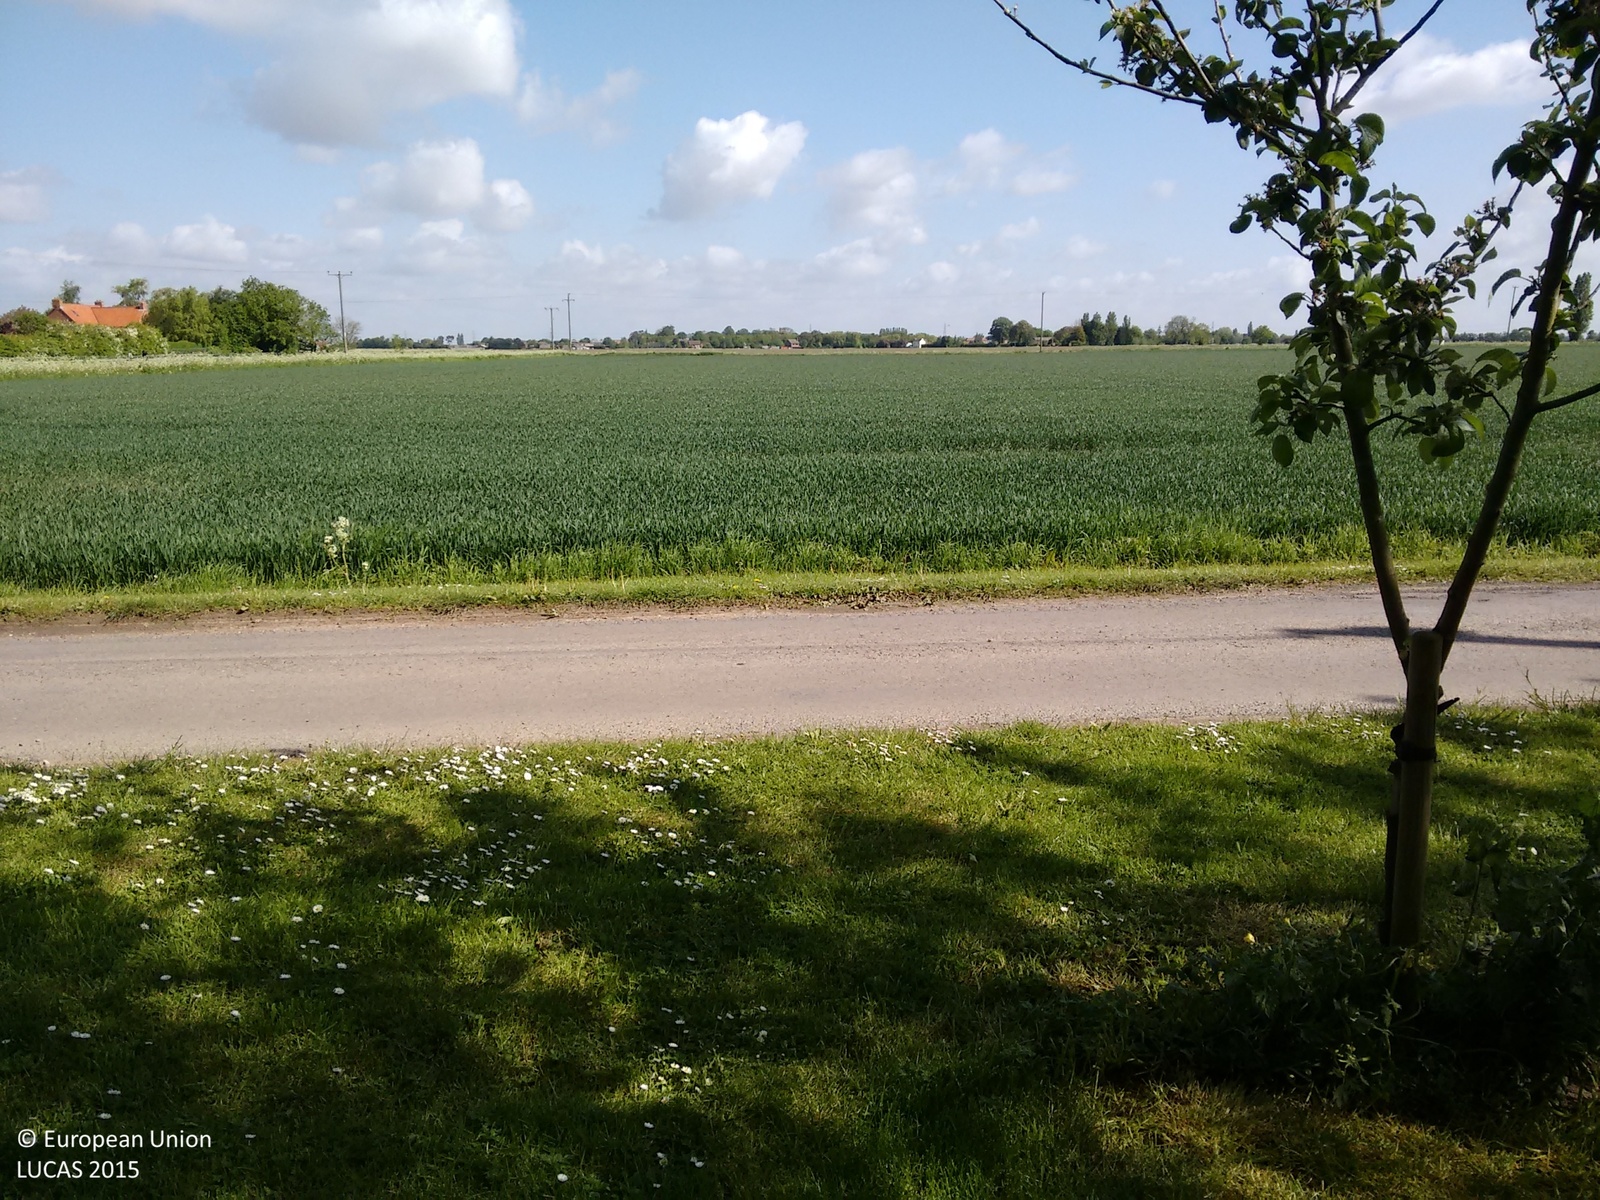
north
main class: Grassland
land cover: Grassland without tree/shrub cover
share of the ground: > 75 %
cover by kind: herbaceous plants 80 %, unconsolidated bare surface 20 %
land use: Logistics and storage
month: May
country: GB
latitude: 52.7843
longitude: -0.0408
